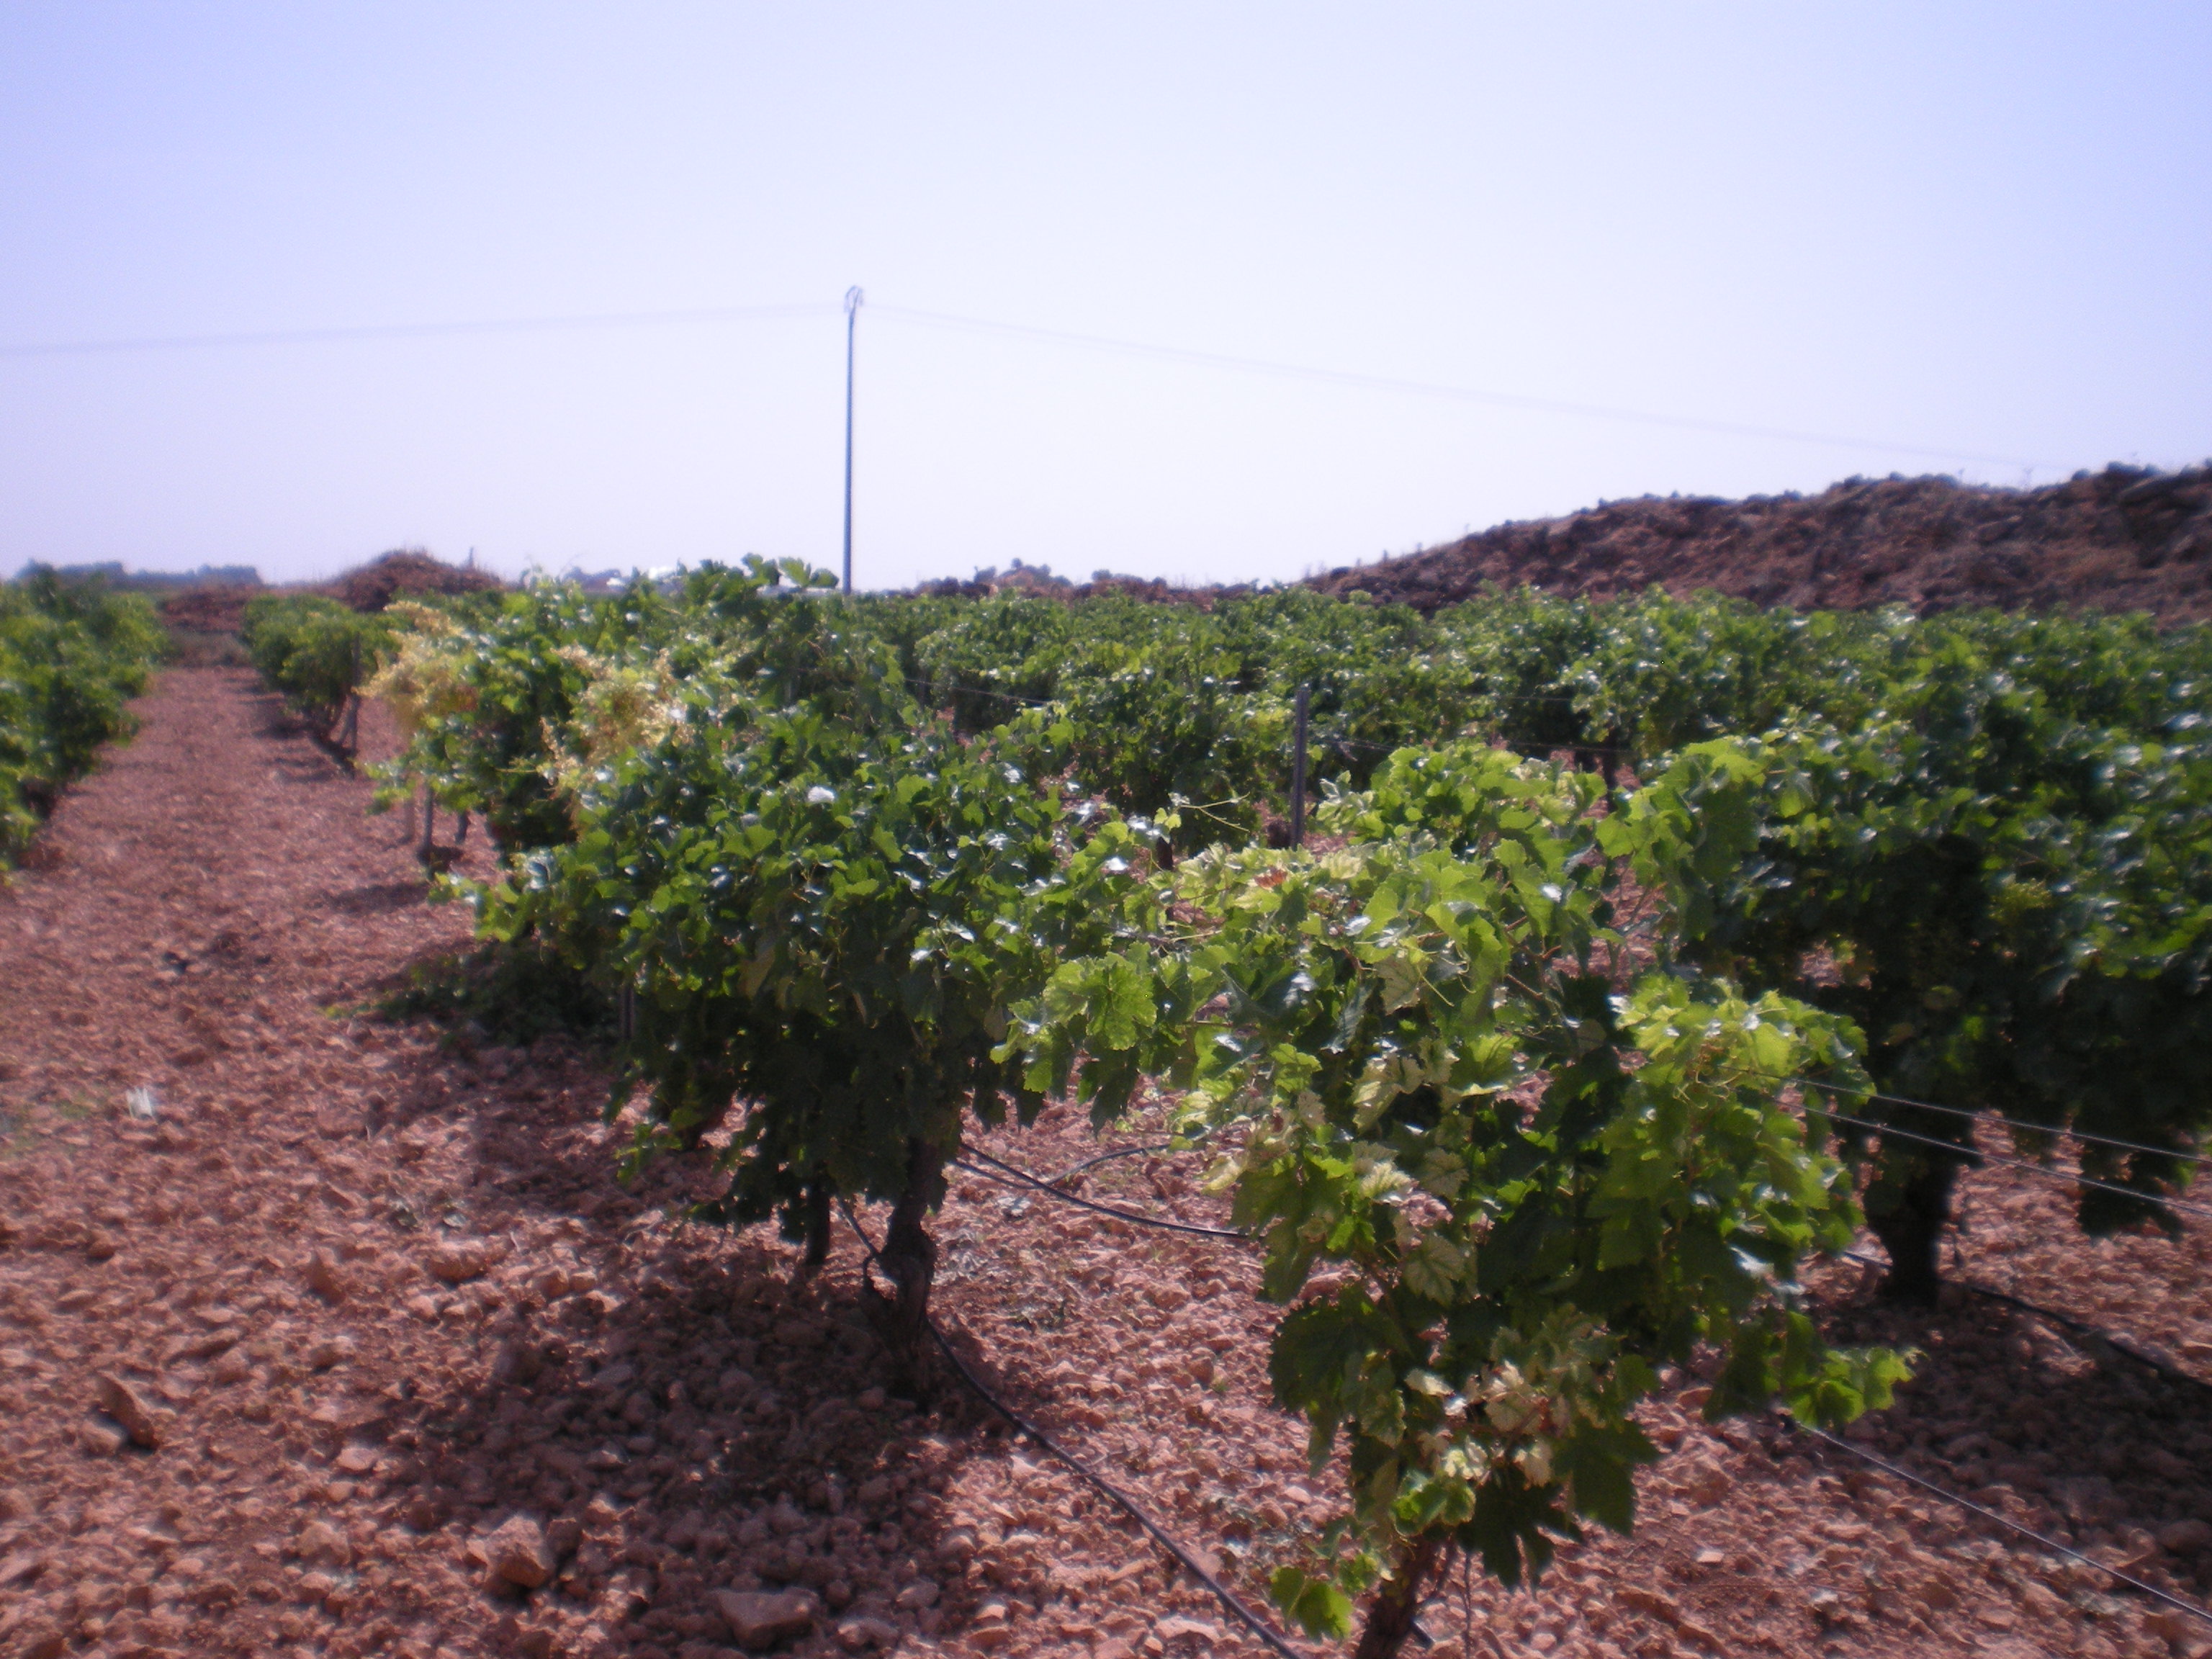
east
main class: Cropland
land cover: Vineyards
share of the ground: 10 - 25 %
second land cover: Other bare soil
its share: > 75 %
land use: Agriculture (excluding fallow land and kitchen gardens)
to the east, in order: Vineyards; Other bare soil; Tracks; Dry stone walls; Grass margins; Other fresh vegetables; Electric lines; Other fresh vegetables
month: July
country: ES
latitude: 39.1994
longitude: -3.2508
